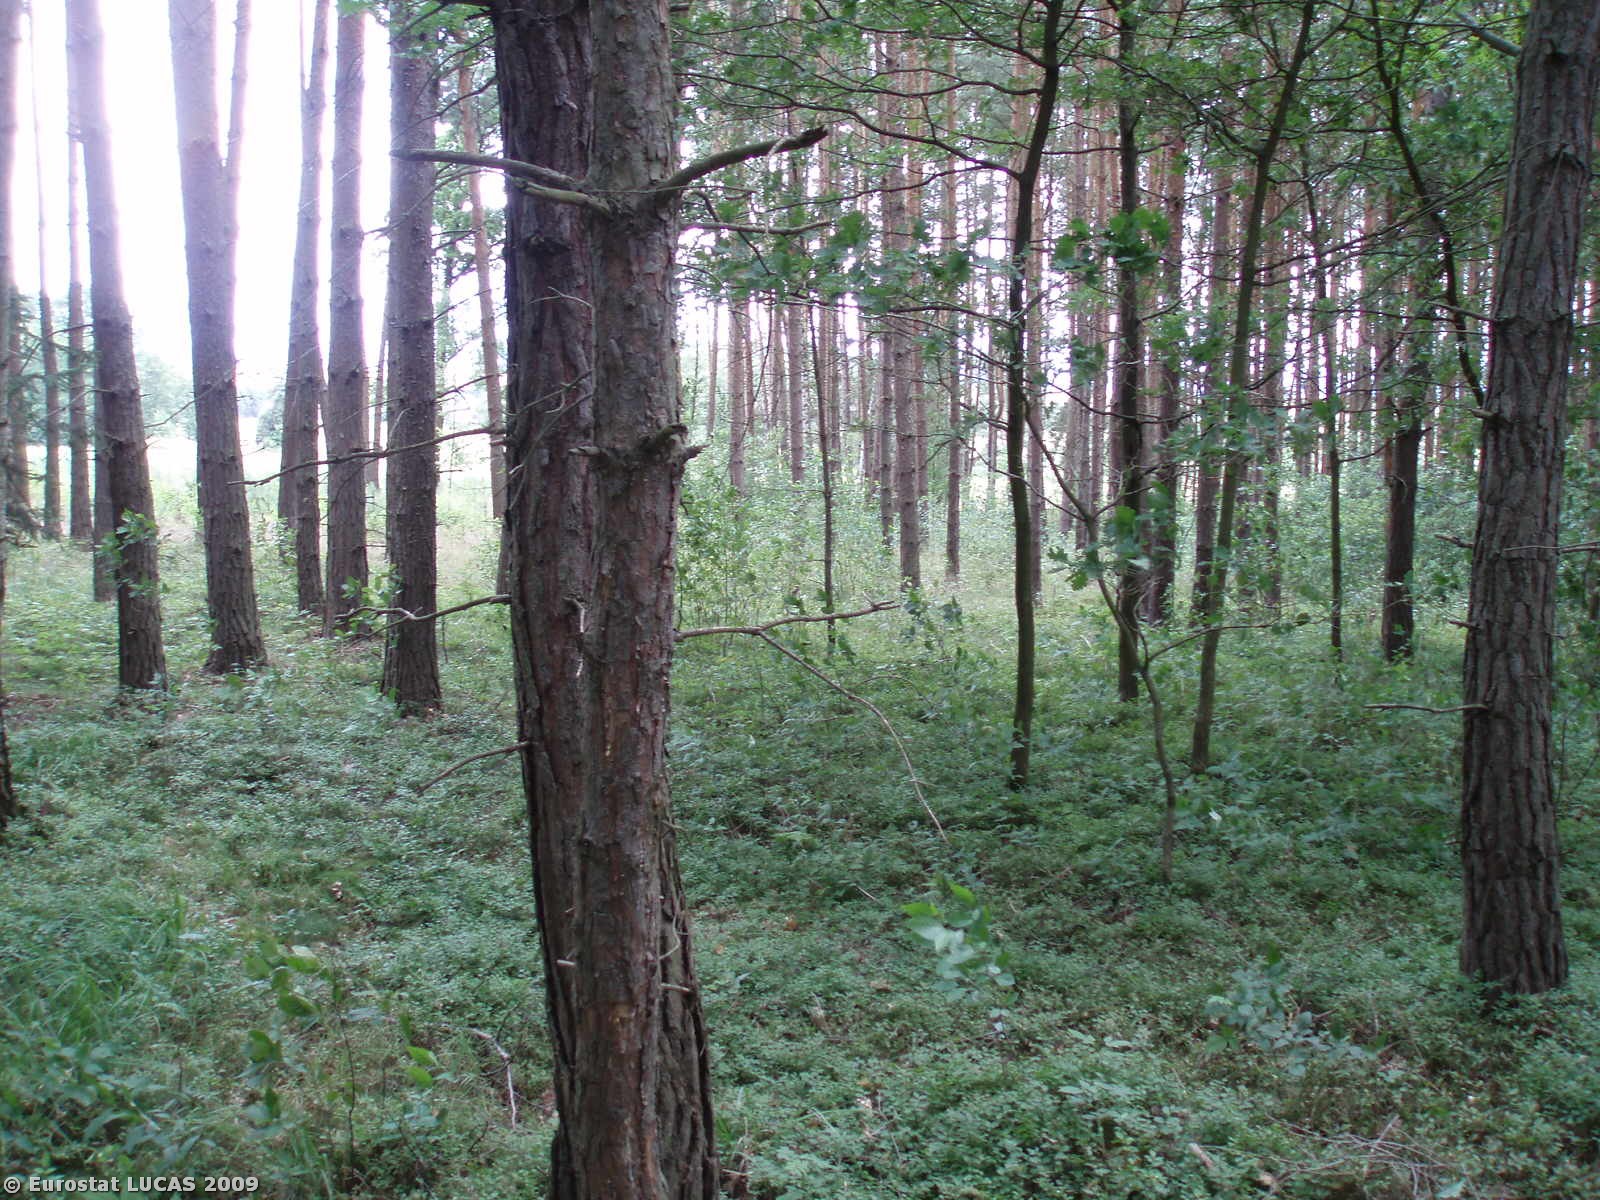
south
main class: Woodland
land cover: Mixed woodland
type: hemiboreal forest and nemoral coniferous forest and mixed broadleaved-coniferous forest
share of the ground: > 75 %
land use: Forestry
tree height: > 5 m
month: July
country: CZ
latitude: 49.5718
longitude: 12.8898
